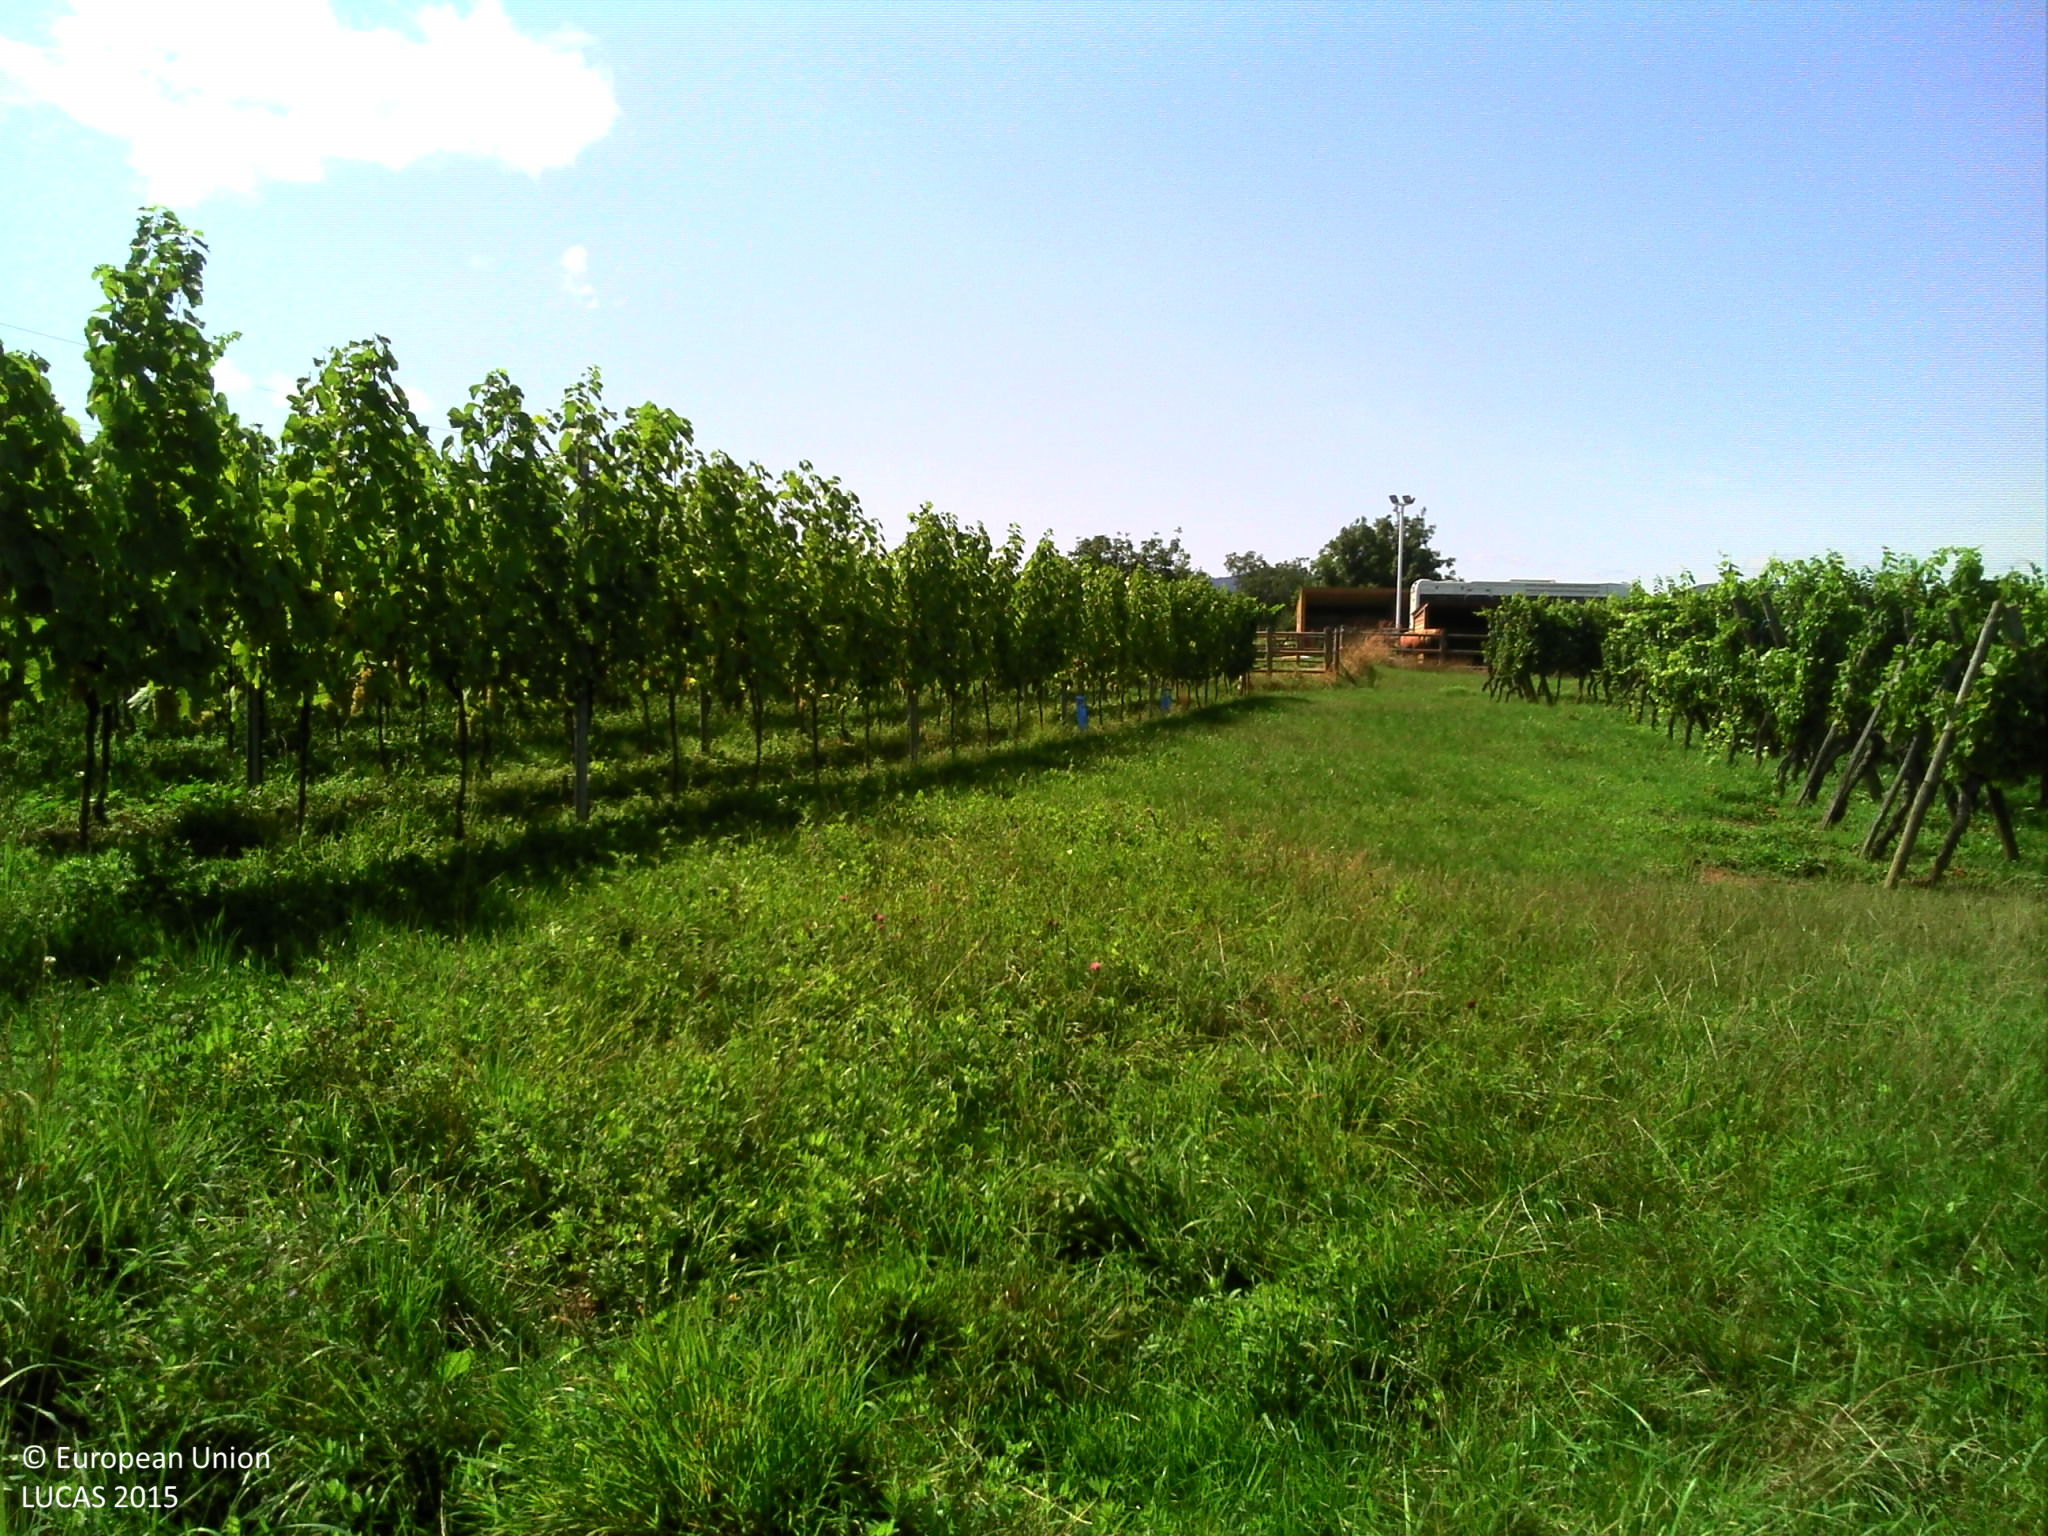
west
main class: Grassland
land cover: Grassland with sparse tree/shrub cover
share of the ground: > 75 %
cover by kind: herbaceous plants 95 %, broadleaved forest trees 5 %
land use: Agriculture (excluding fallow land and kitchen gardens)
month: August
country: FR
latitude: 48.3567
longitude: 7.4772
